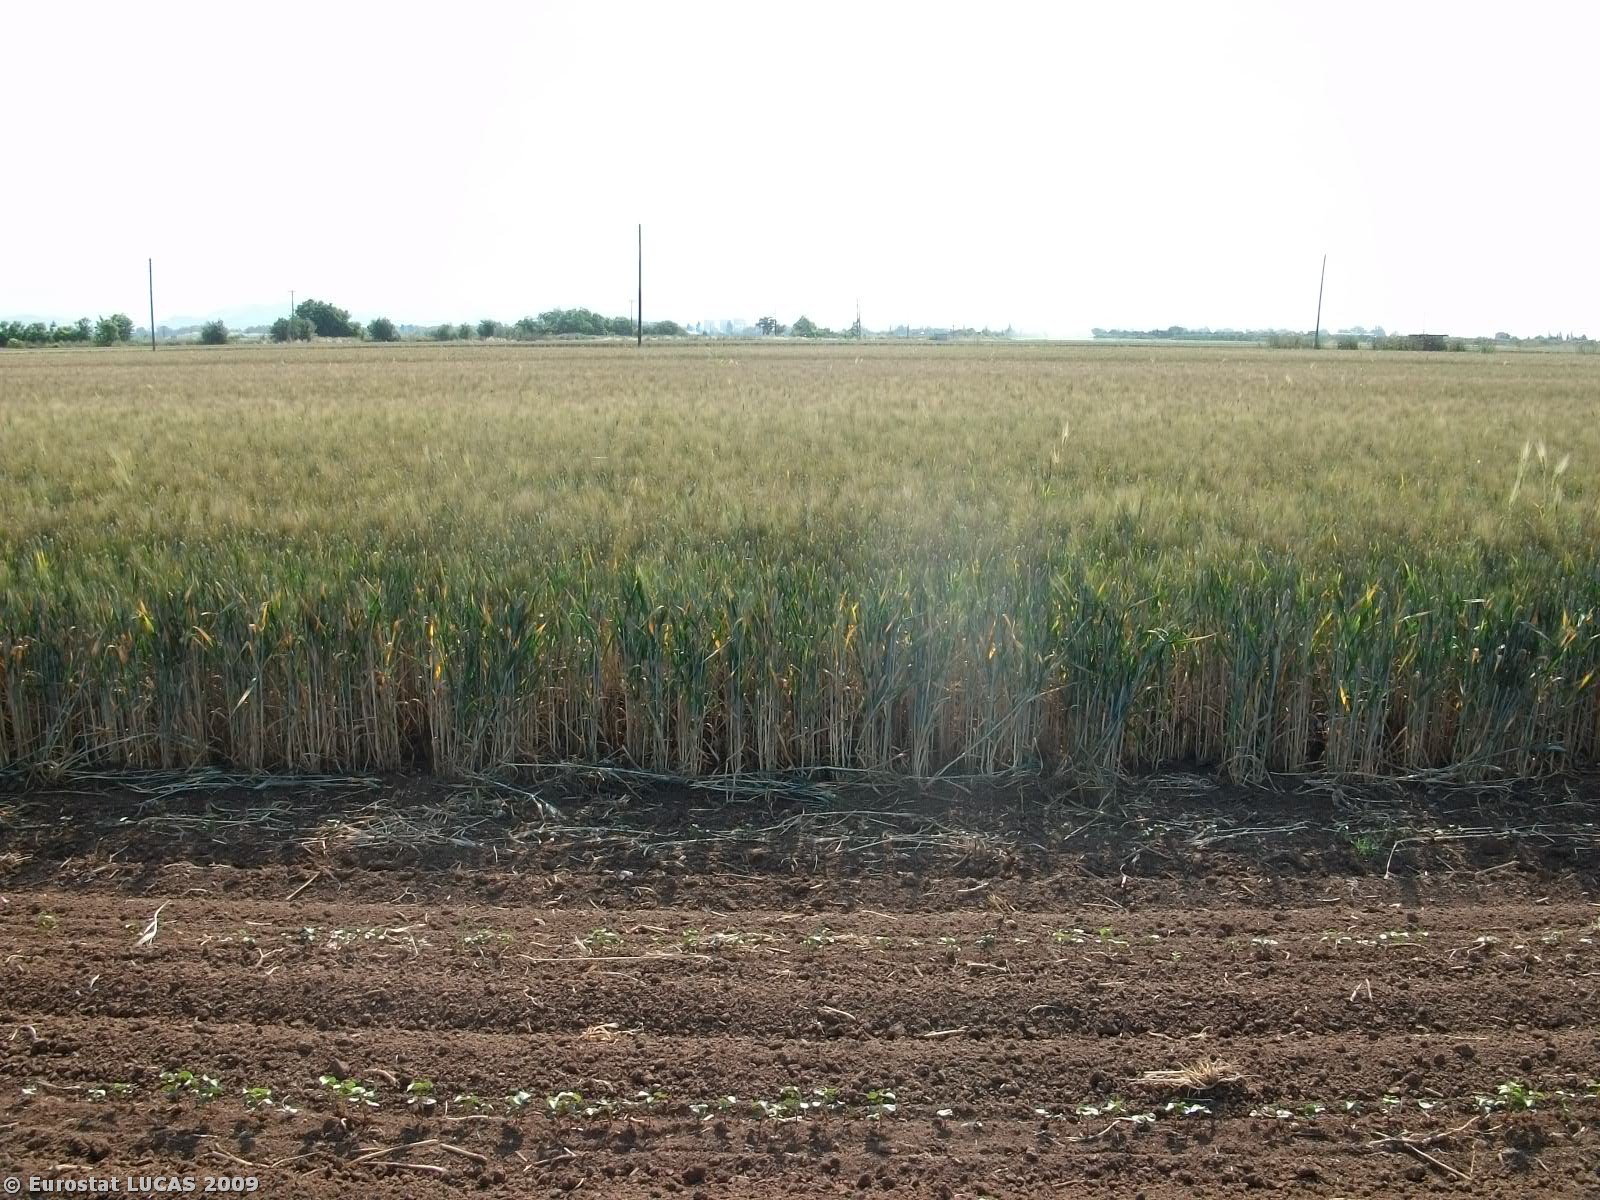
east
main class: Cropland
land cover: Cotton
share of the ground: < 10 %
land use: Agriculture (excluding fallow land and kitchen gardens)
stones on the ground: < 10 %
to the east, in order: Cotton; Durum wheat; Cotton; Electric lines; Cotton; Durum wheat; Cotton
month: May
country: GR
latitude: 39.6777
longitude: 22.4066
